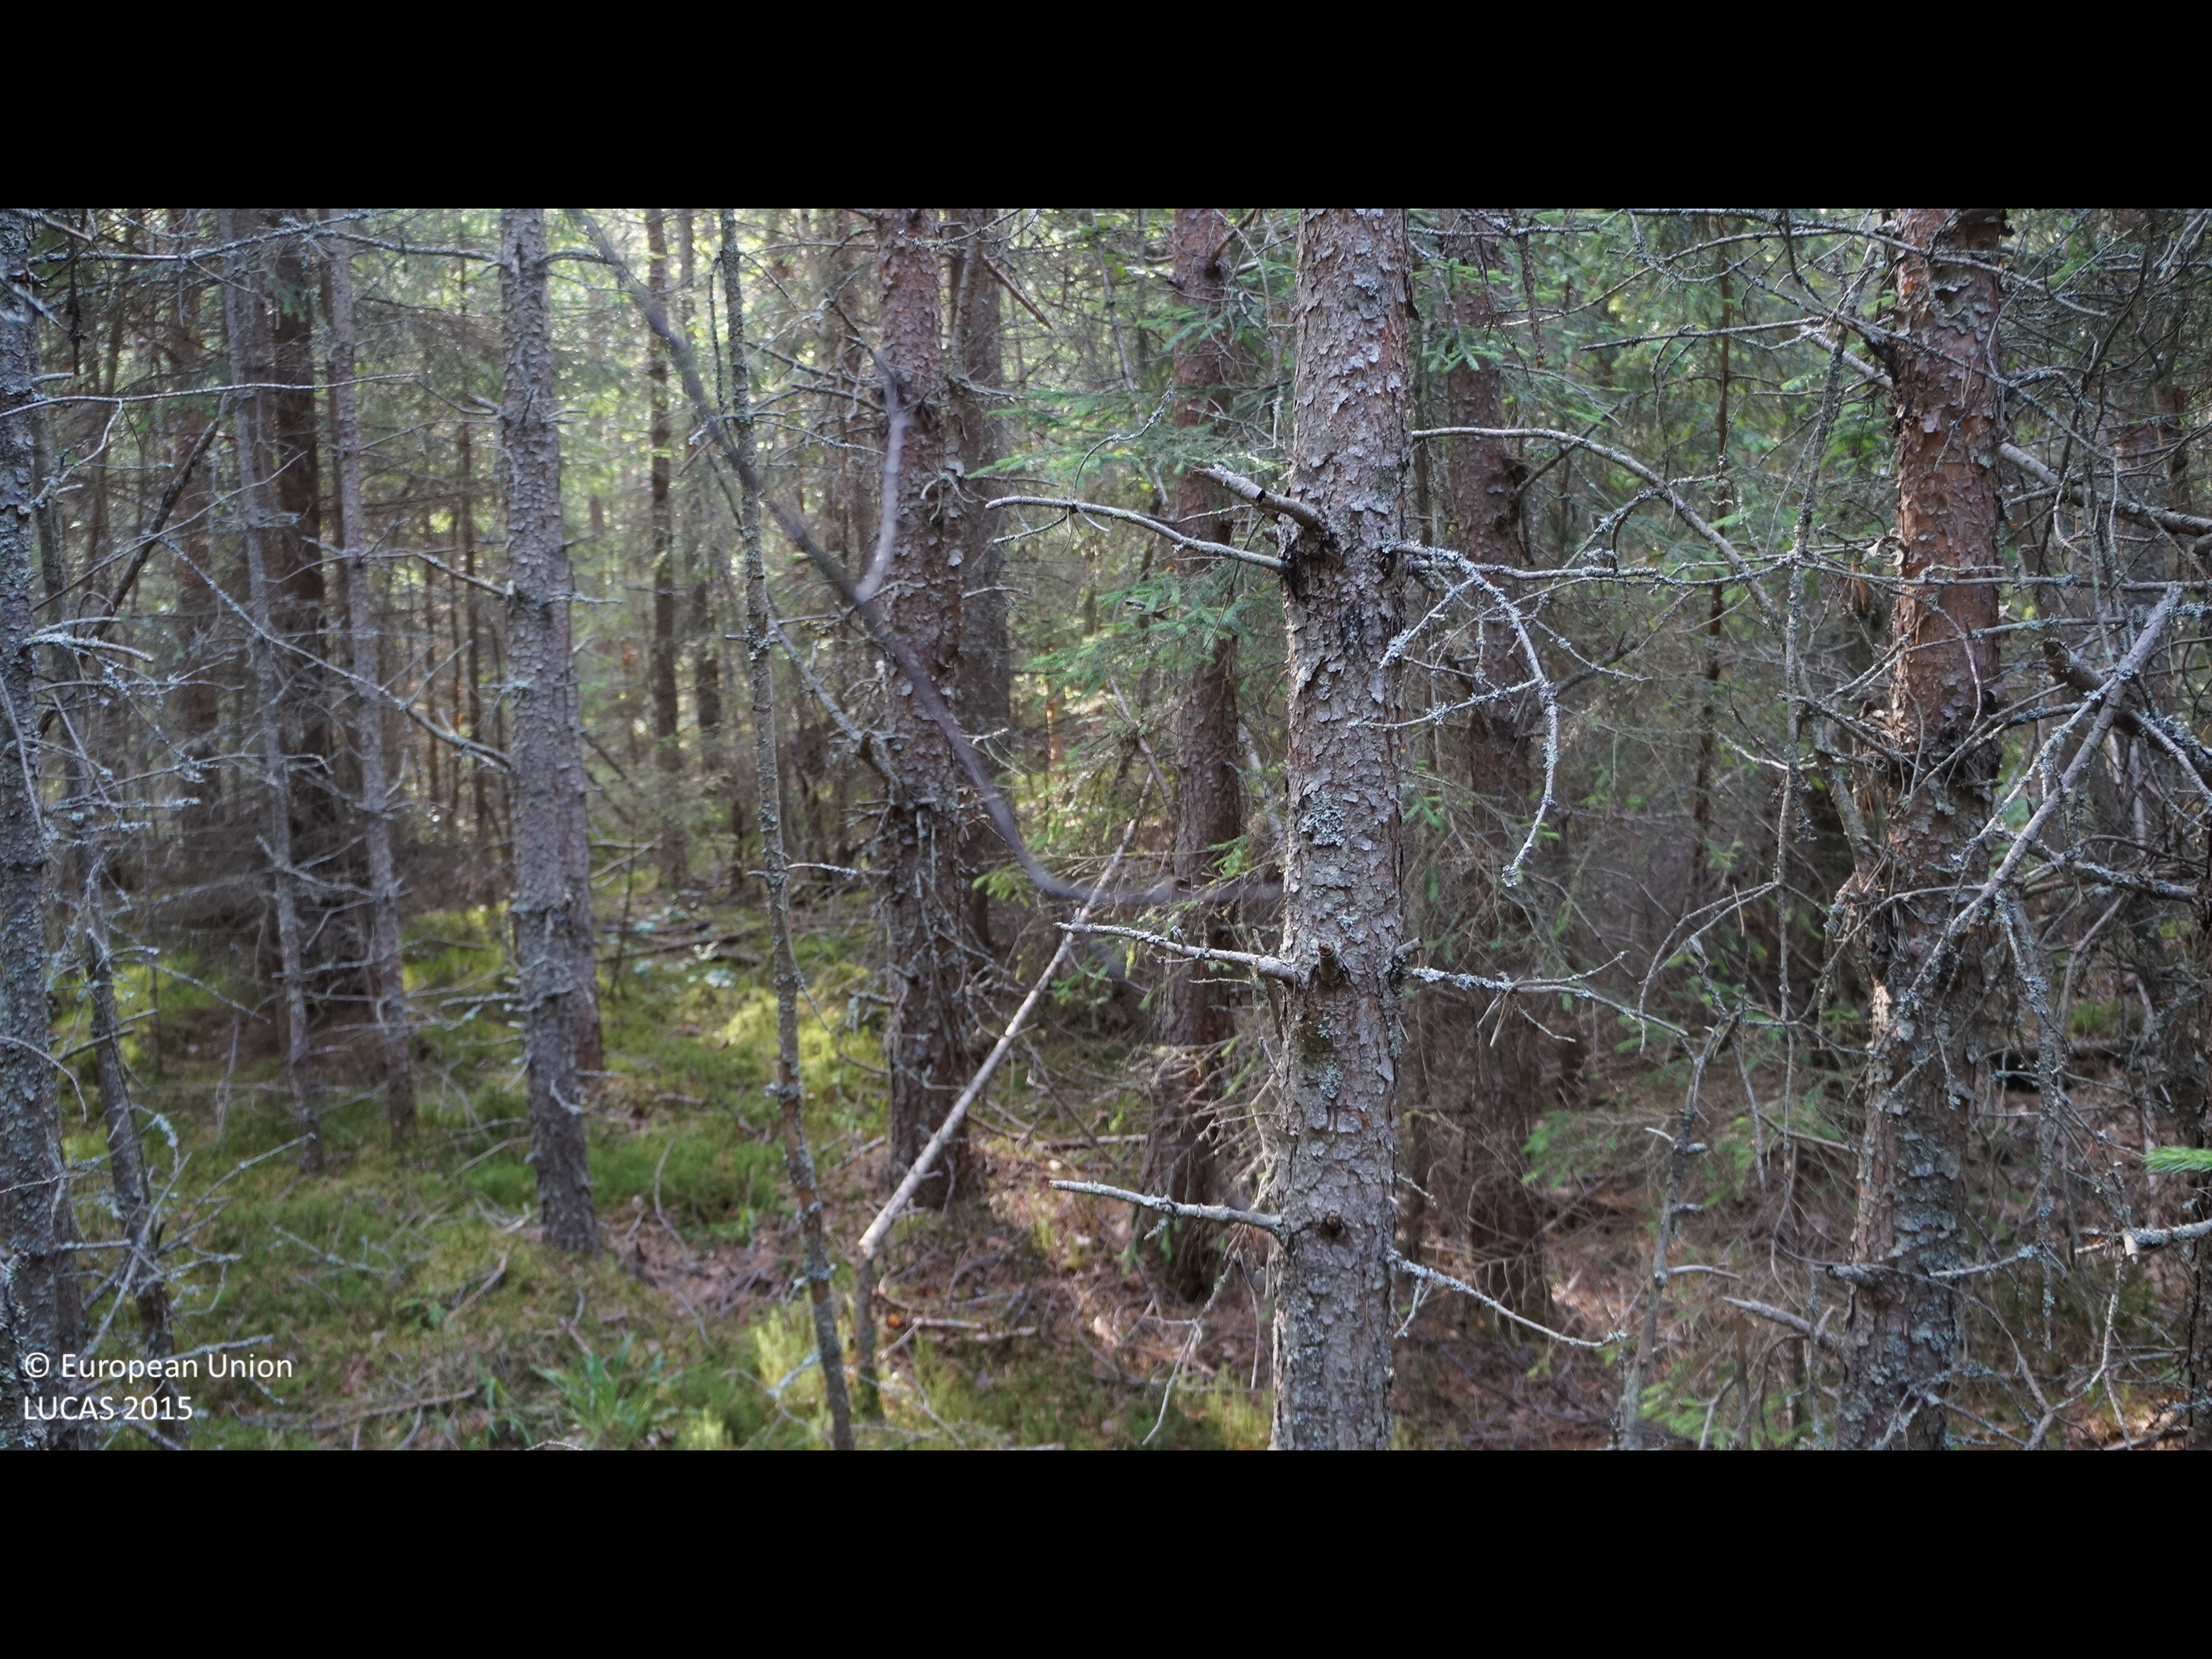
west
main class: Woodland
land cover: Pine dominated mixed woodland
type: boreal forest
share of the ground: > 75 %
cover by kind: coniferous forest trees 55 %, broadleaved forest trees 20 %, lichens and mosses 15 %, shrubs 10 %
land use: Forestry
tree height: > 5 m
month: July
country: FI
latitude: 64.7443
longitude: 24.6688
